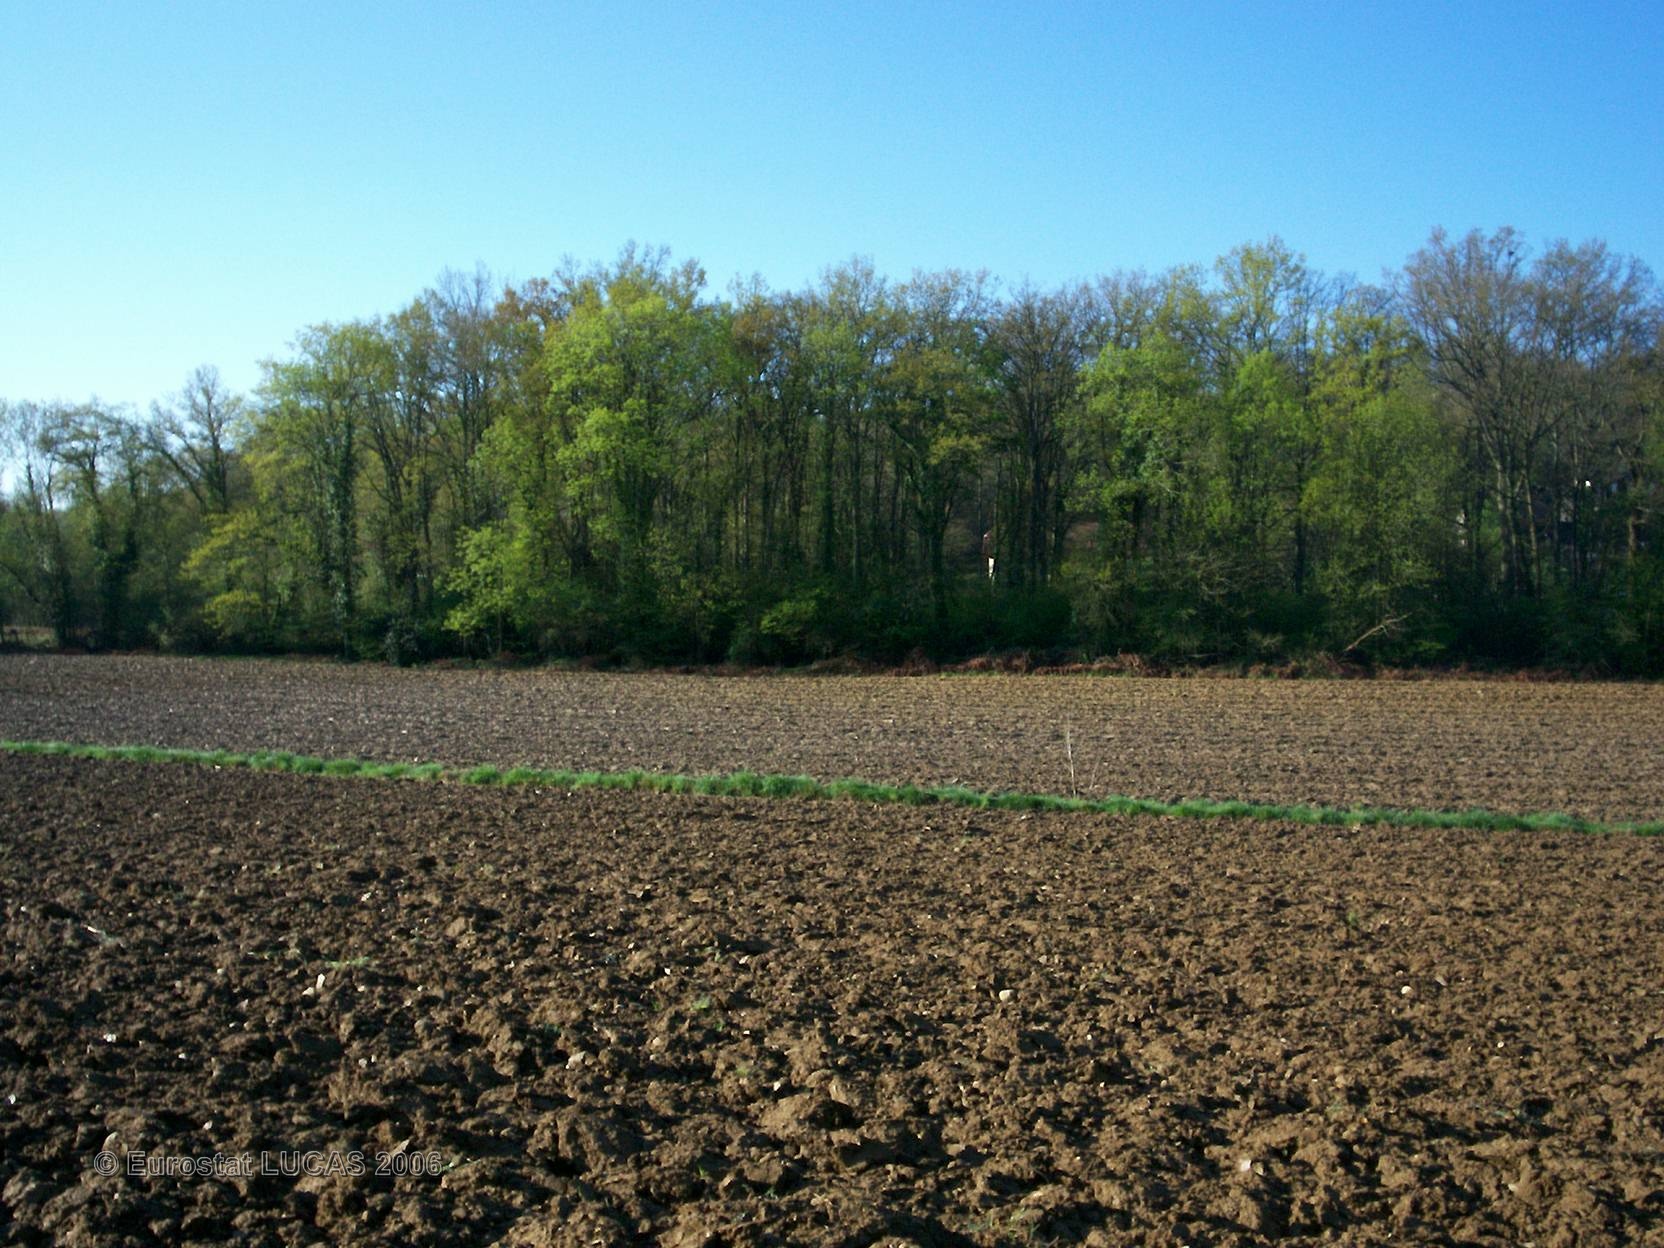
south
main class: Cropland
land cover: Maize
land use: Agriculture (excluding fallow land and kitchen gardens)
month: June
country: FR
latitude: 43.3631
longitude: -0.3103
